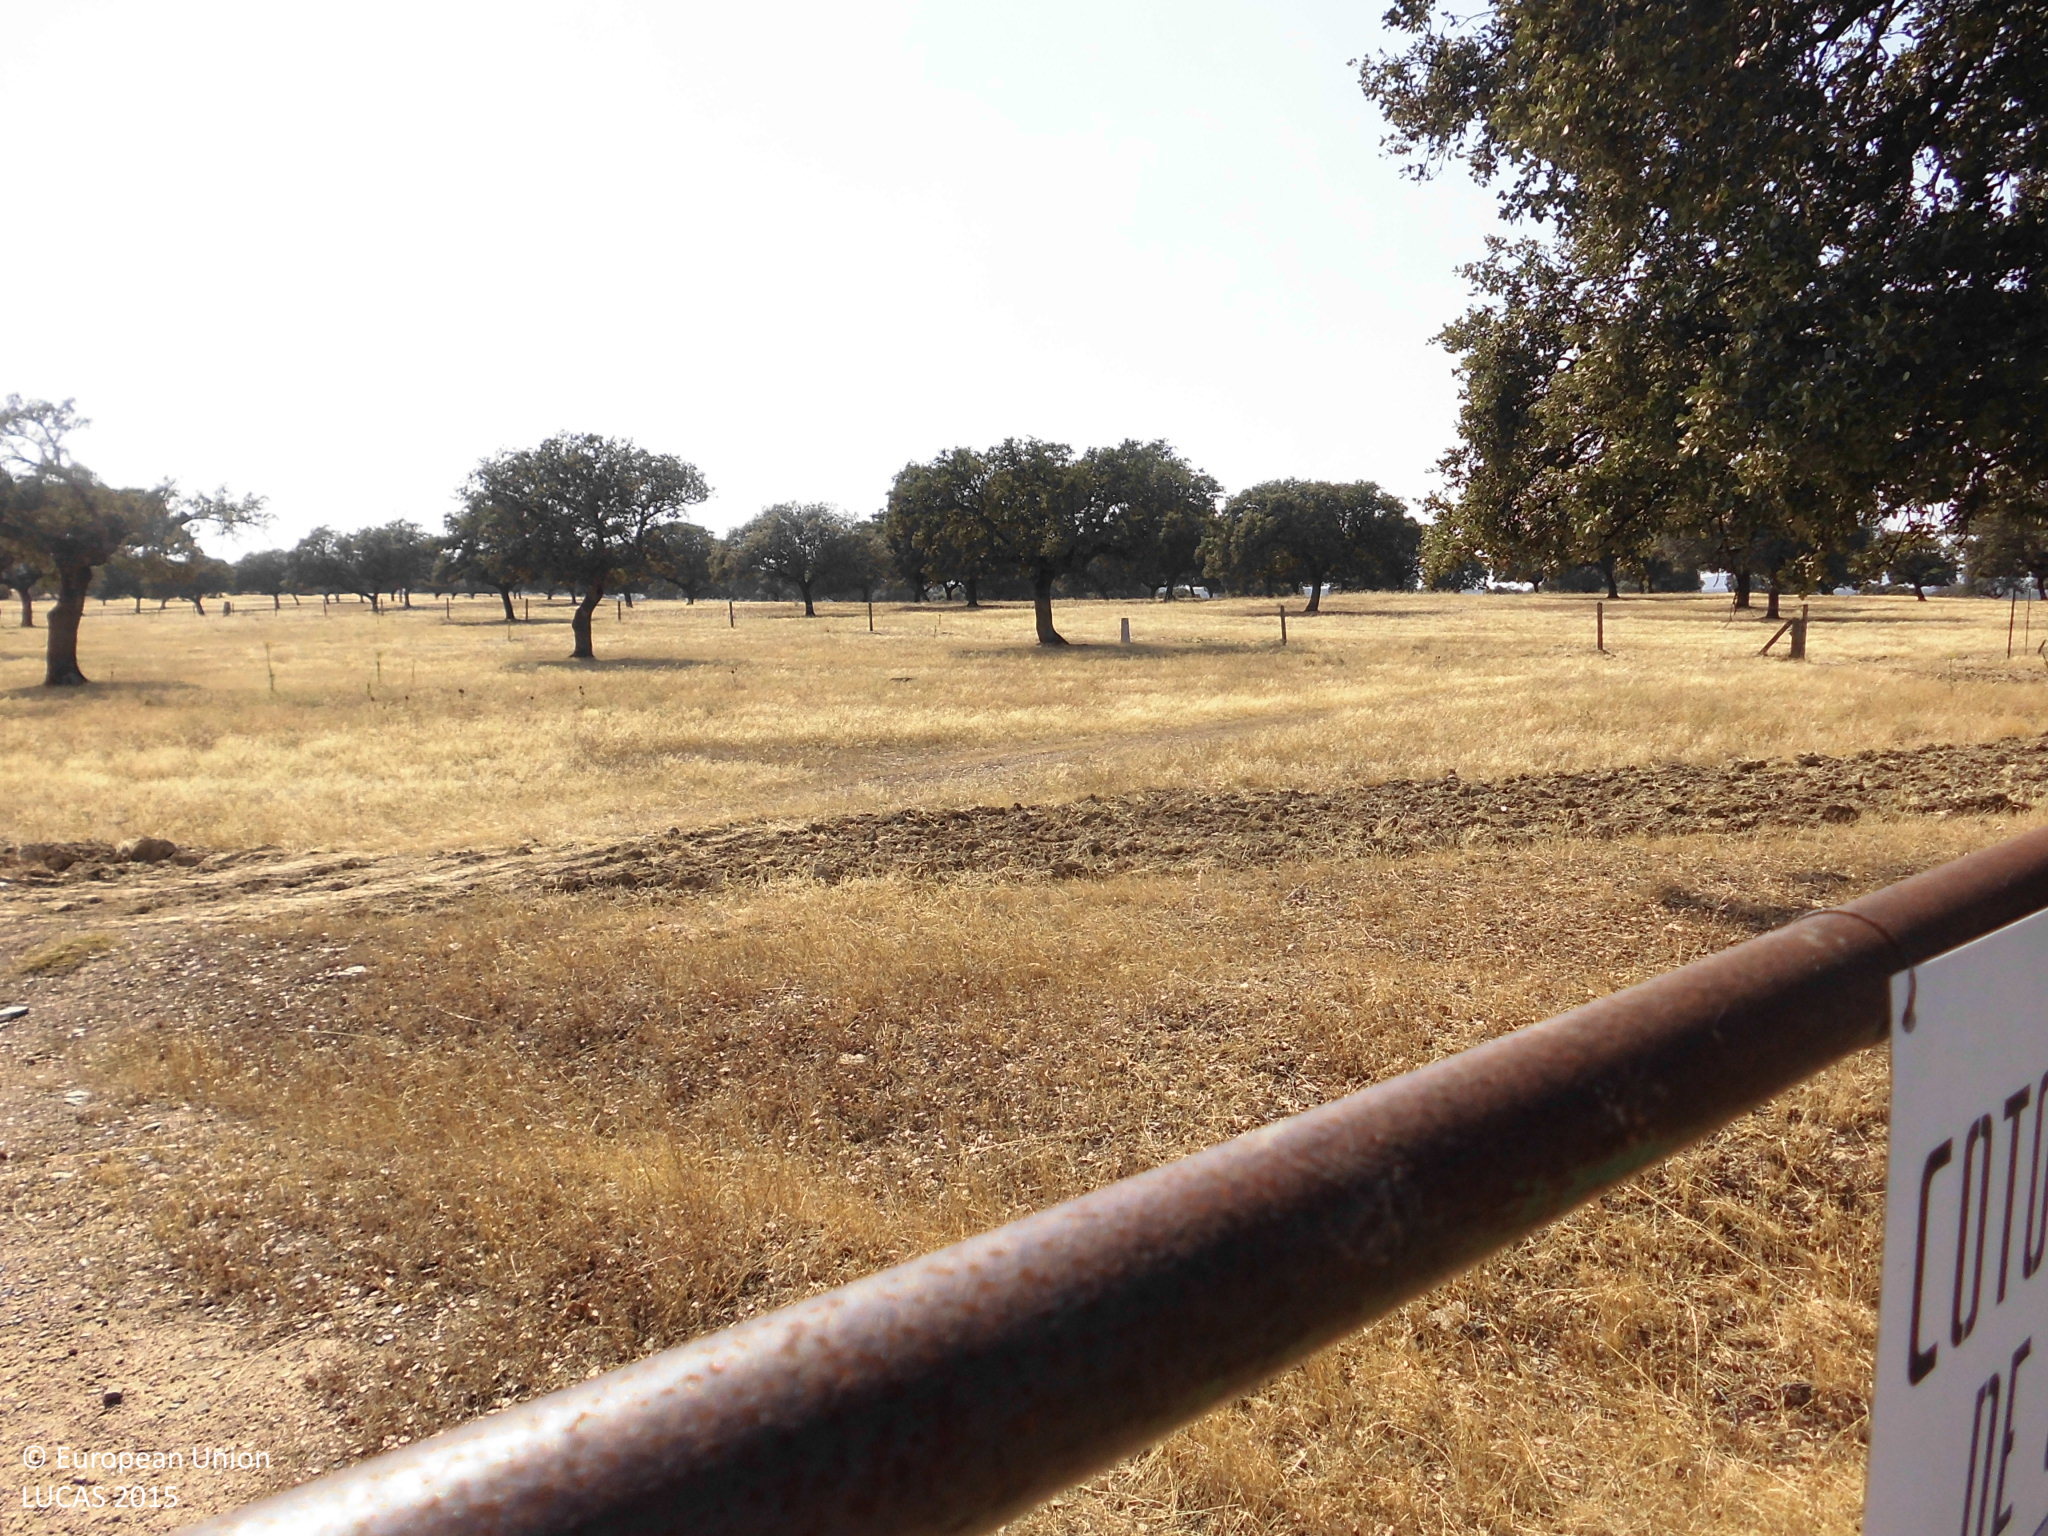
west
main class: Grassland
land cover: Grassland without tree/shrub cover
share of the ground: > 75 %
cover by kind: herbaceous plants 100 %
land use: Agriculture (excluding fallow land and kitchen gardens)
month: June
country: ES
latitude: 39.9238
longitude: -6.0874
